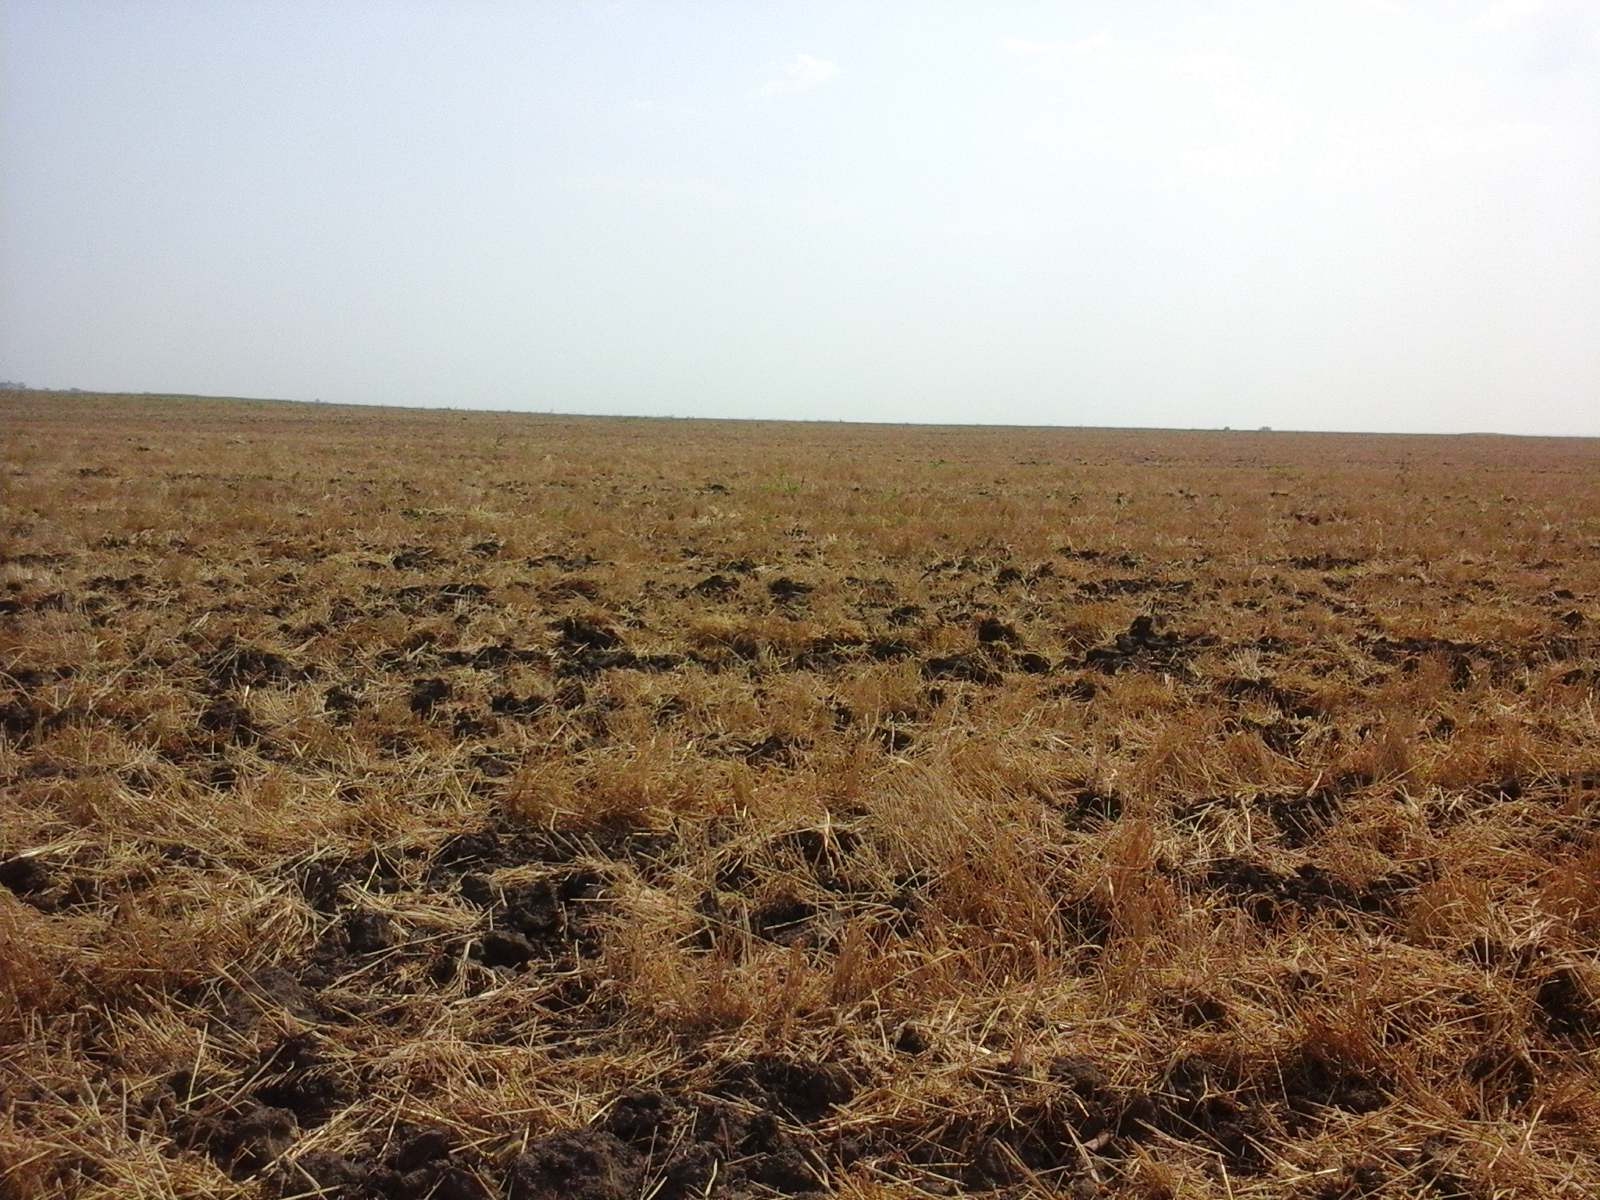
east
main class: Cropland
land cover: Common wheat
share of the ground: 50 - 75 %
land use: Agriculture (excluding fallow land and kitchen gardens)
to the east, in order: Common wheat
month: August
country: RO
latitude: 43.9060
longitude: 23.3311
